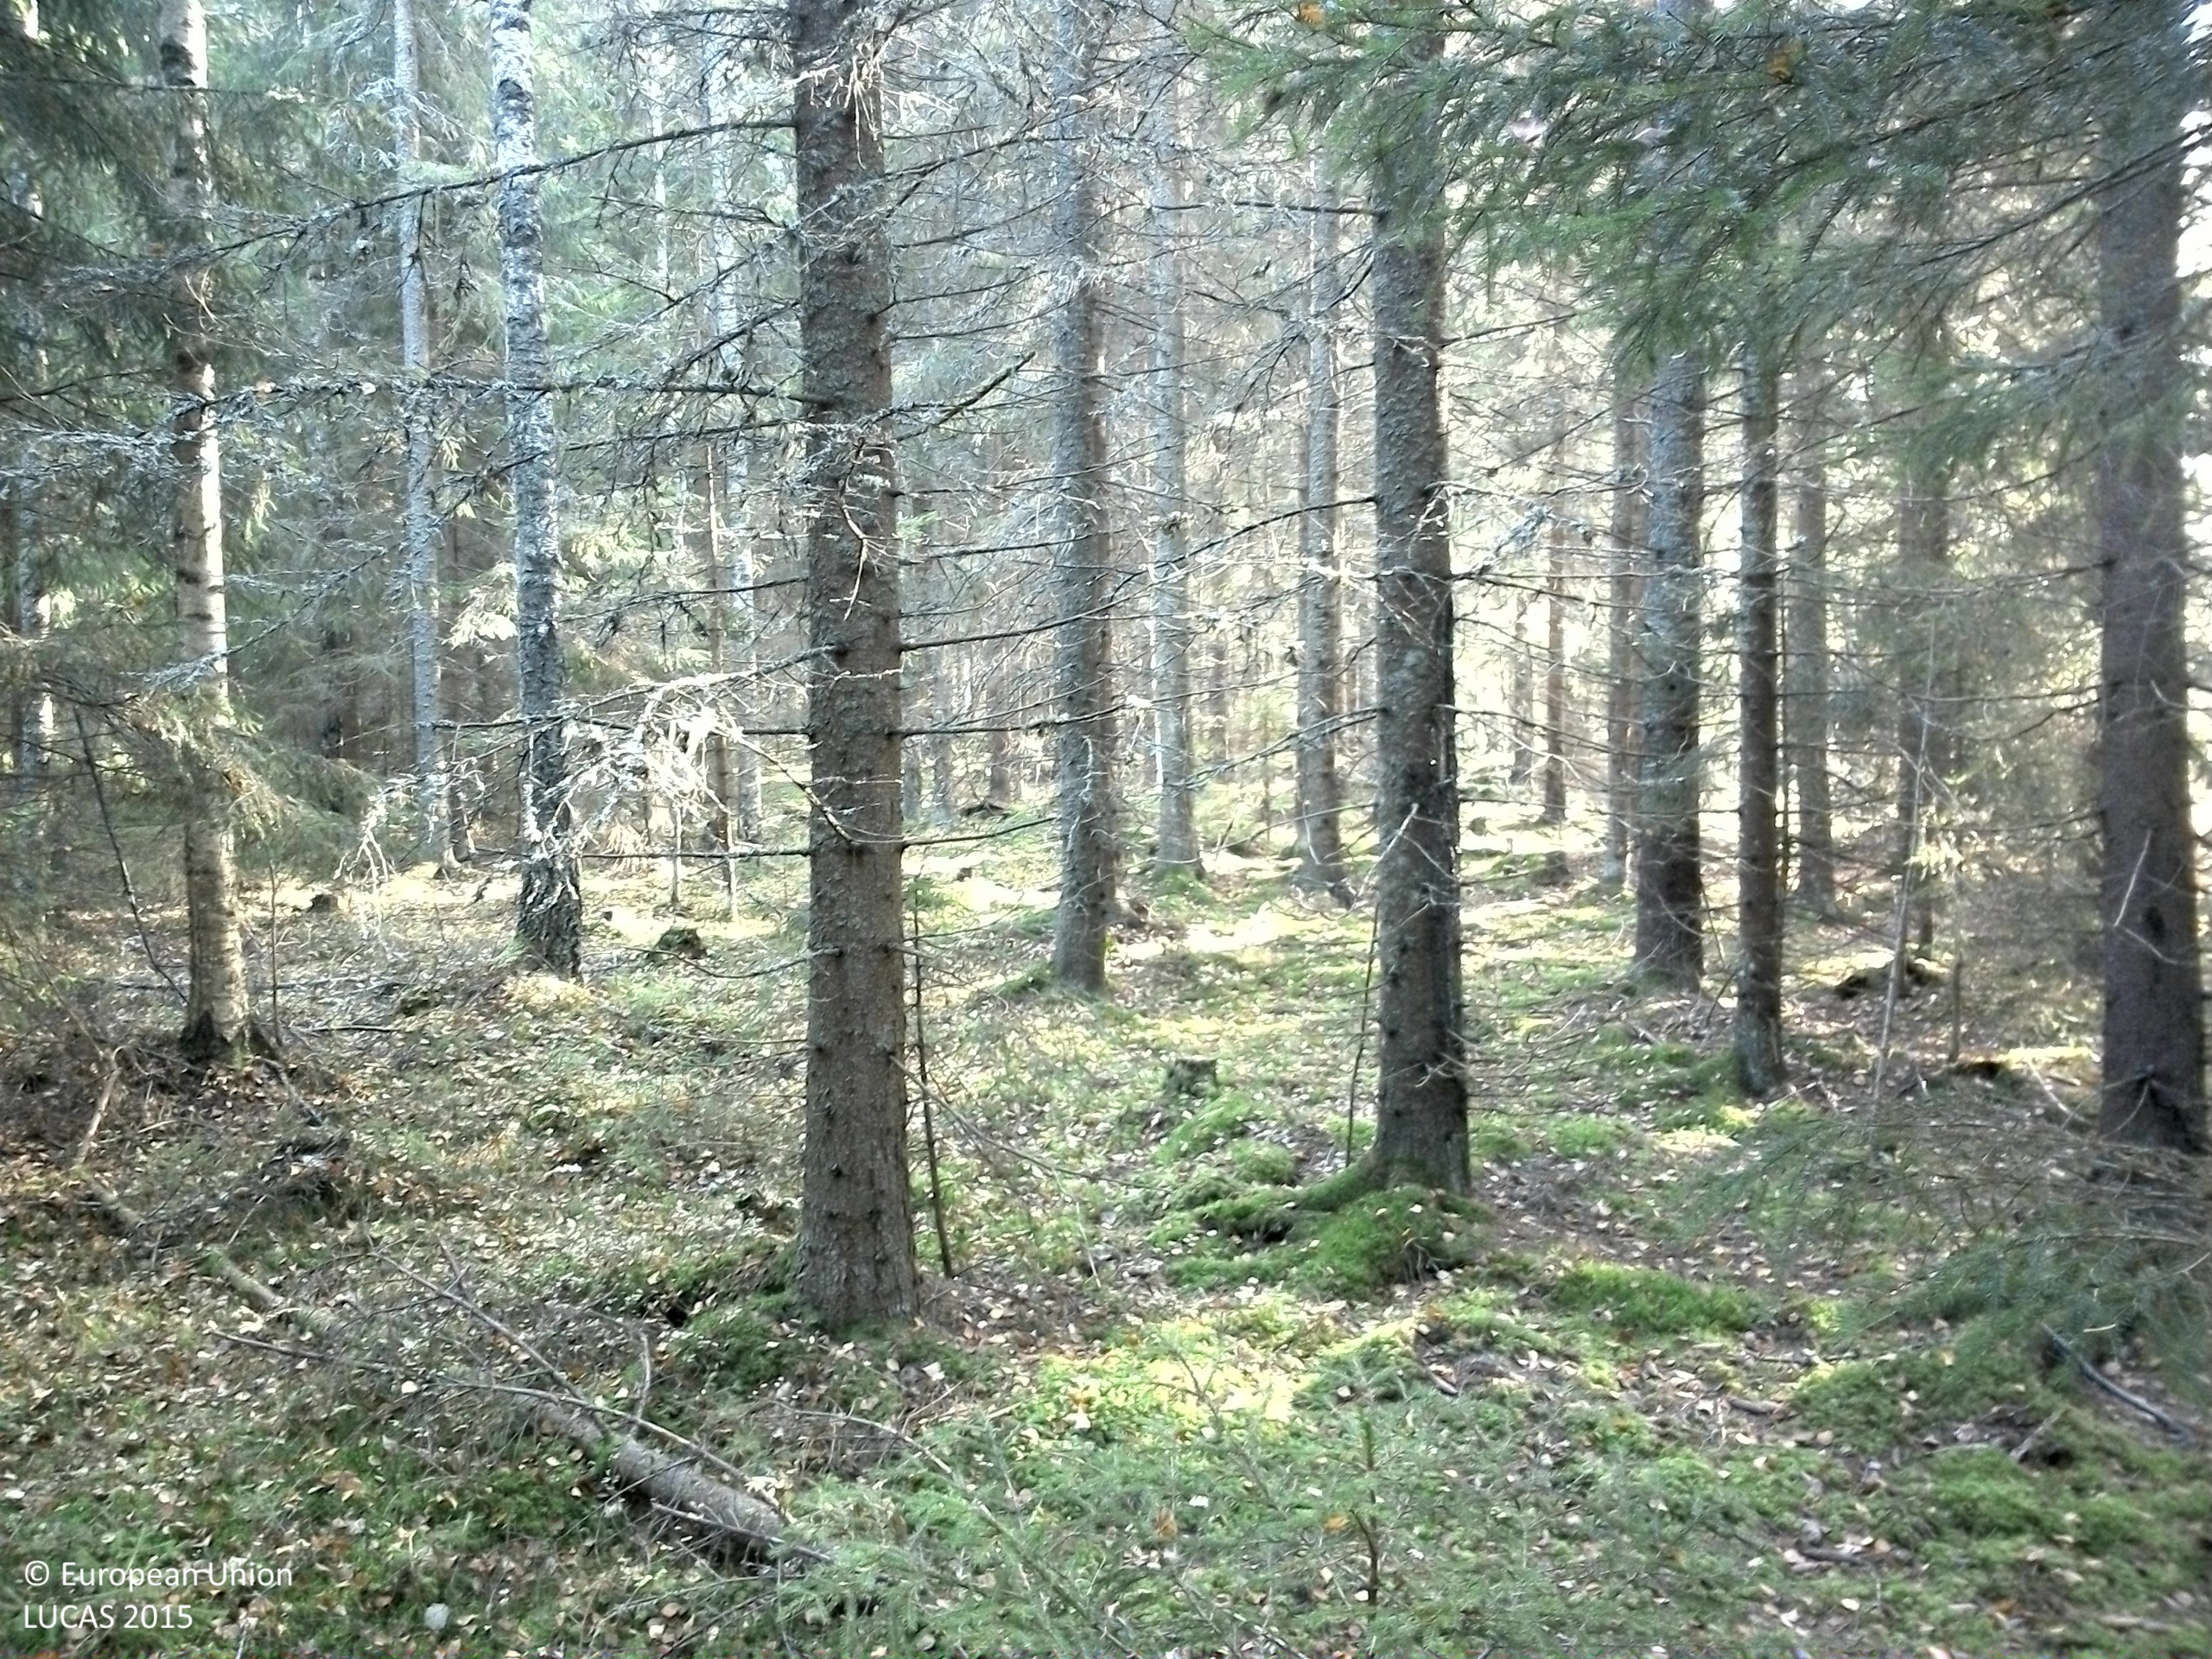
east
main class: Woodland
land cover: Spruce dominated coniferous woodland
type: boreal forest
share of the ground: > 75 %
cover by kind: coniferous forest trees 75 %, shrubs 10 %, lichens and mosses 10 %, broadleaved forest trees 5 %
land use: Forestry
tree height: > 5 m
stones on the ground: < 10 %
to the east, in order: Spruce dominated coniferous woodland; Spruce dominated mixed woodland; Spruce dominated coniferous woodland; Other coniferous woodland; Spruce dominated mixed woodland; Other mixed woodland
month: October
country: SE
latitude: 59.7961
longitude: 16.4959
